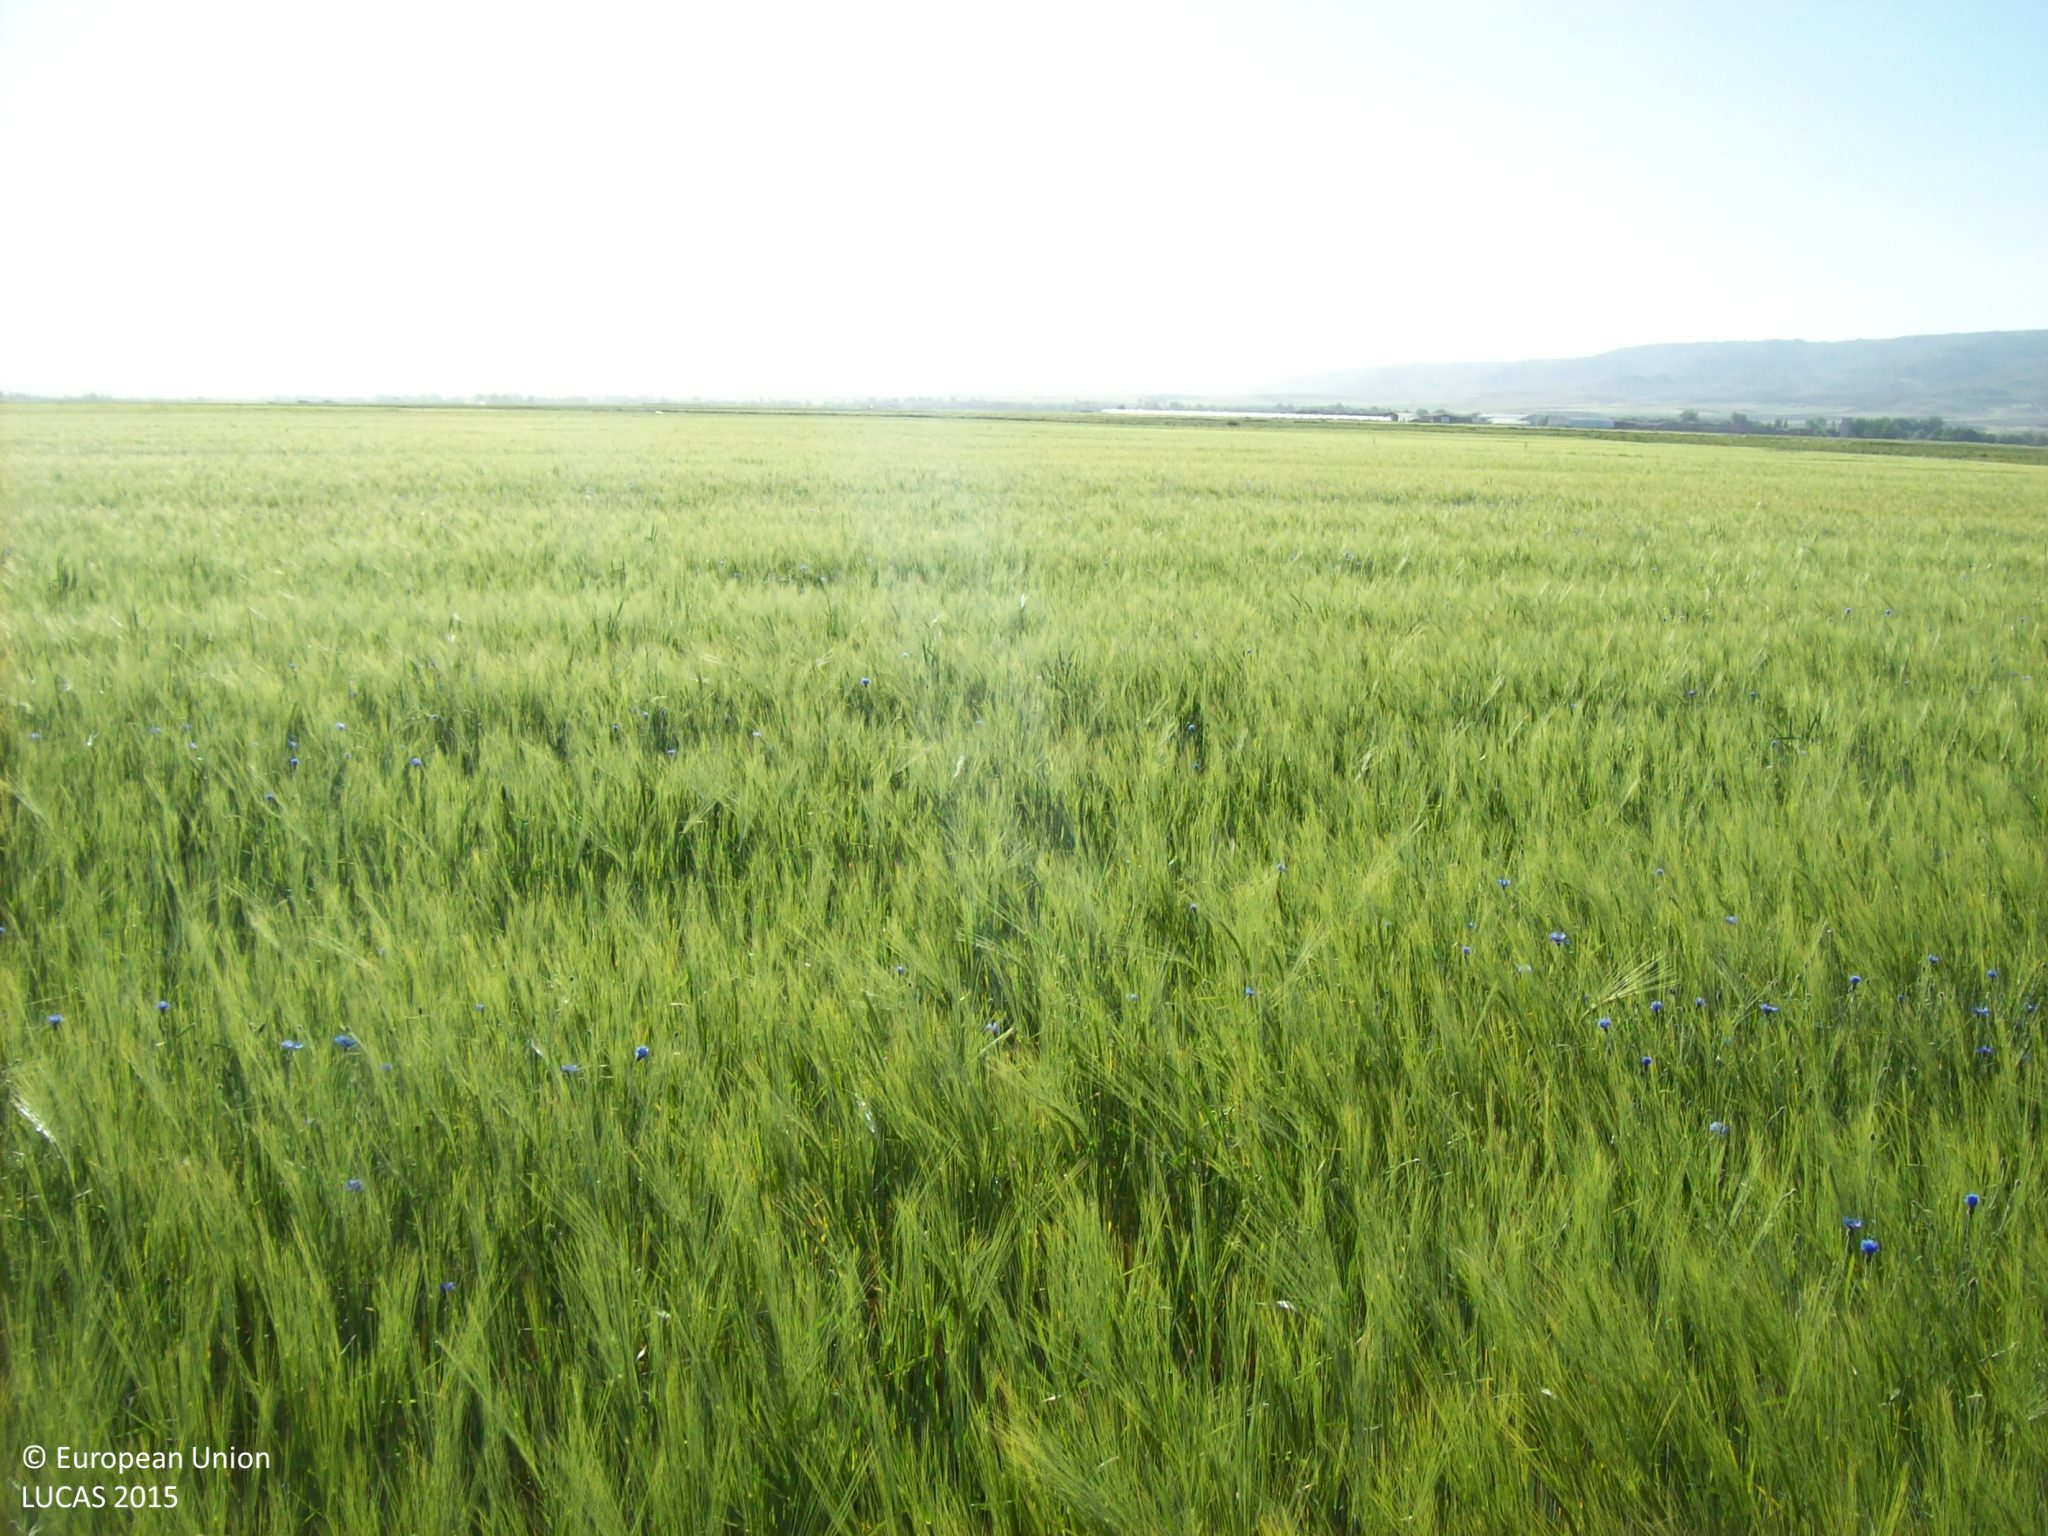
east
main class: Cropland
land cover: Barley
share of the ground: > 75 %
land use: Agriculture (excluding fallow land and kitchen gardens)
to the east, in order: Barley; Grass margins; Barley; Grass margins; Mixed cereals for fodder
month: May
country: ES
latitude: 40.5965
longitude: -4.8638
